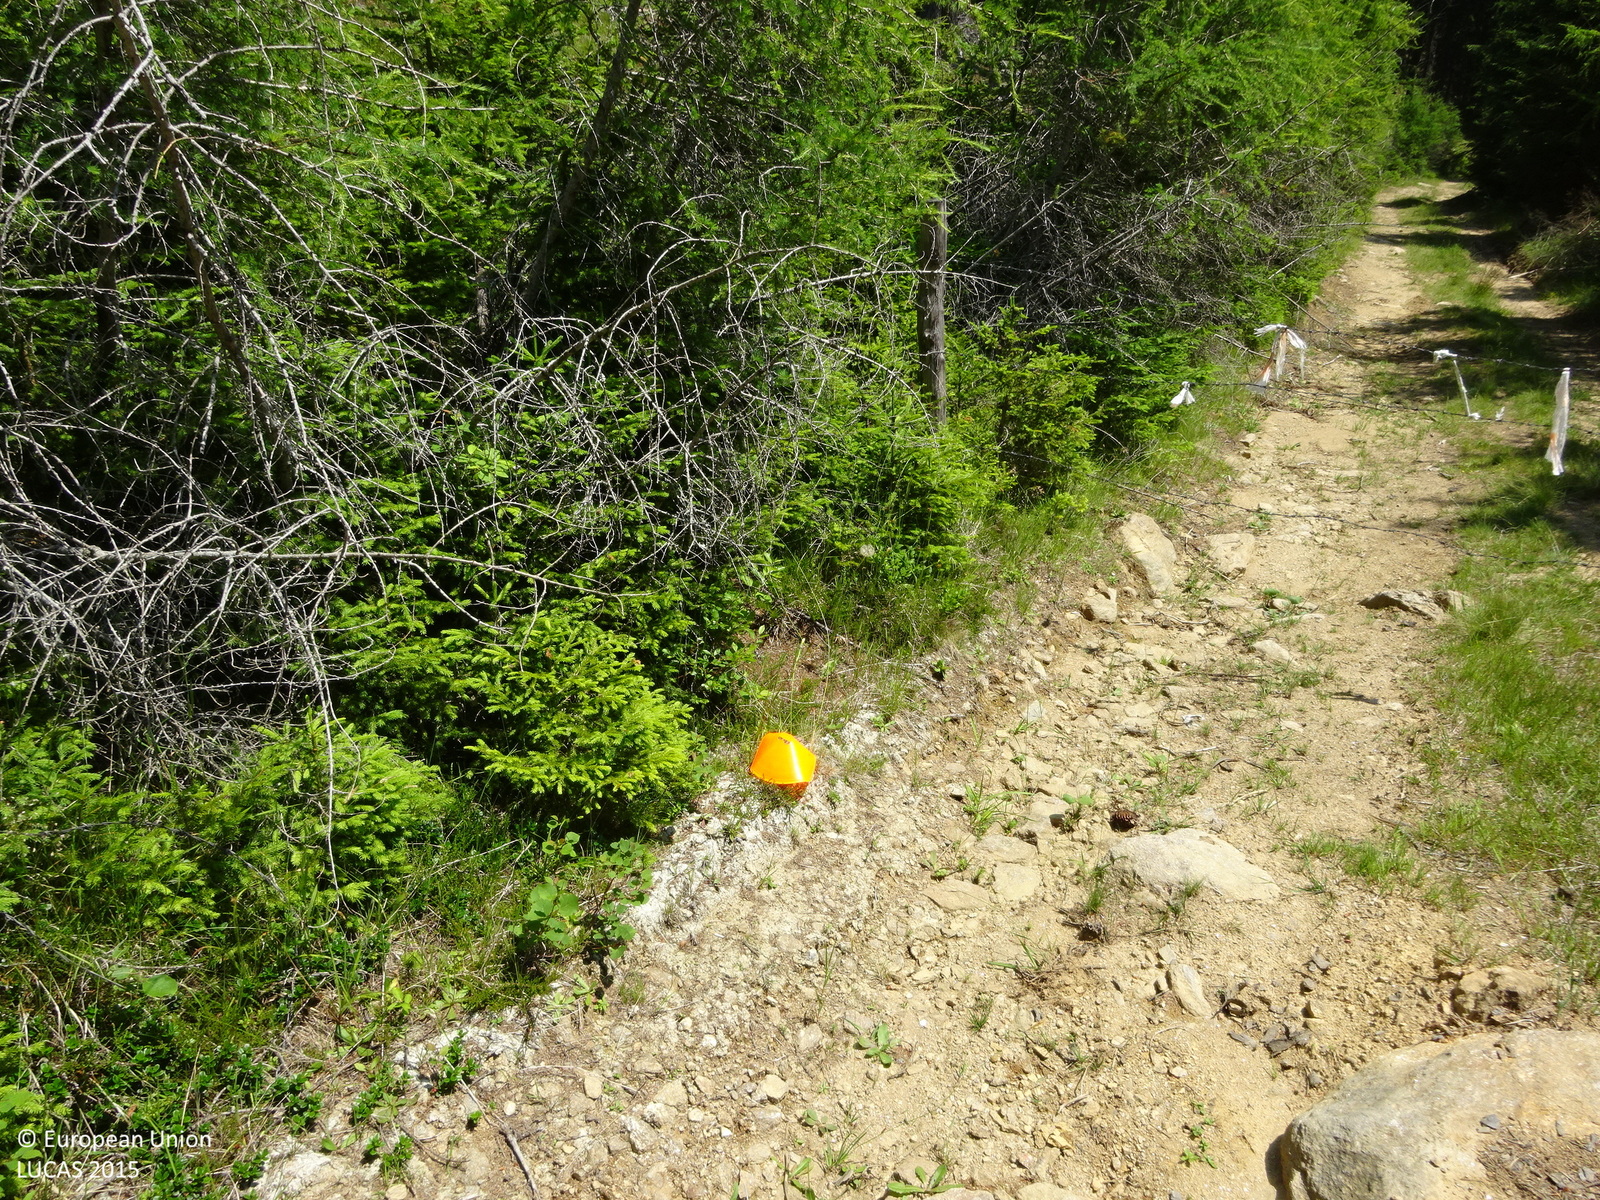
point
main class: Woodland
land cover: Other coniferous woodland
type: alpine coniferous forest
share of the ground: > 75 %
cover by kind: coniferous forest trees 75 %, herbaceous plants 25 %
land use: Forestry
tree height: > 5 m
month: July
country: AT
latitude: 47.0659
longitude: 14.9631
